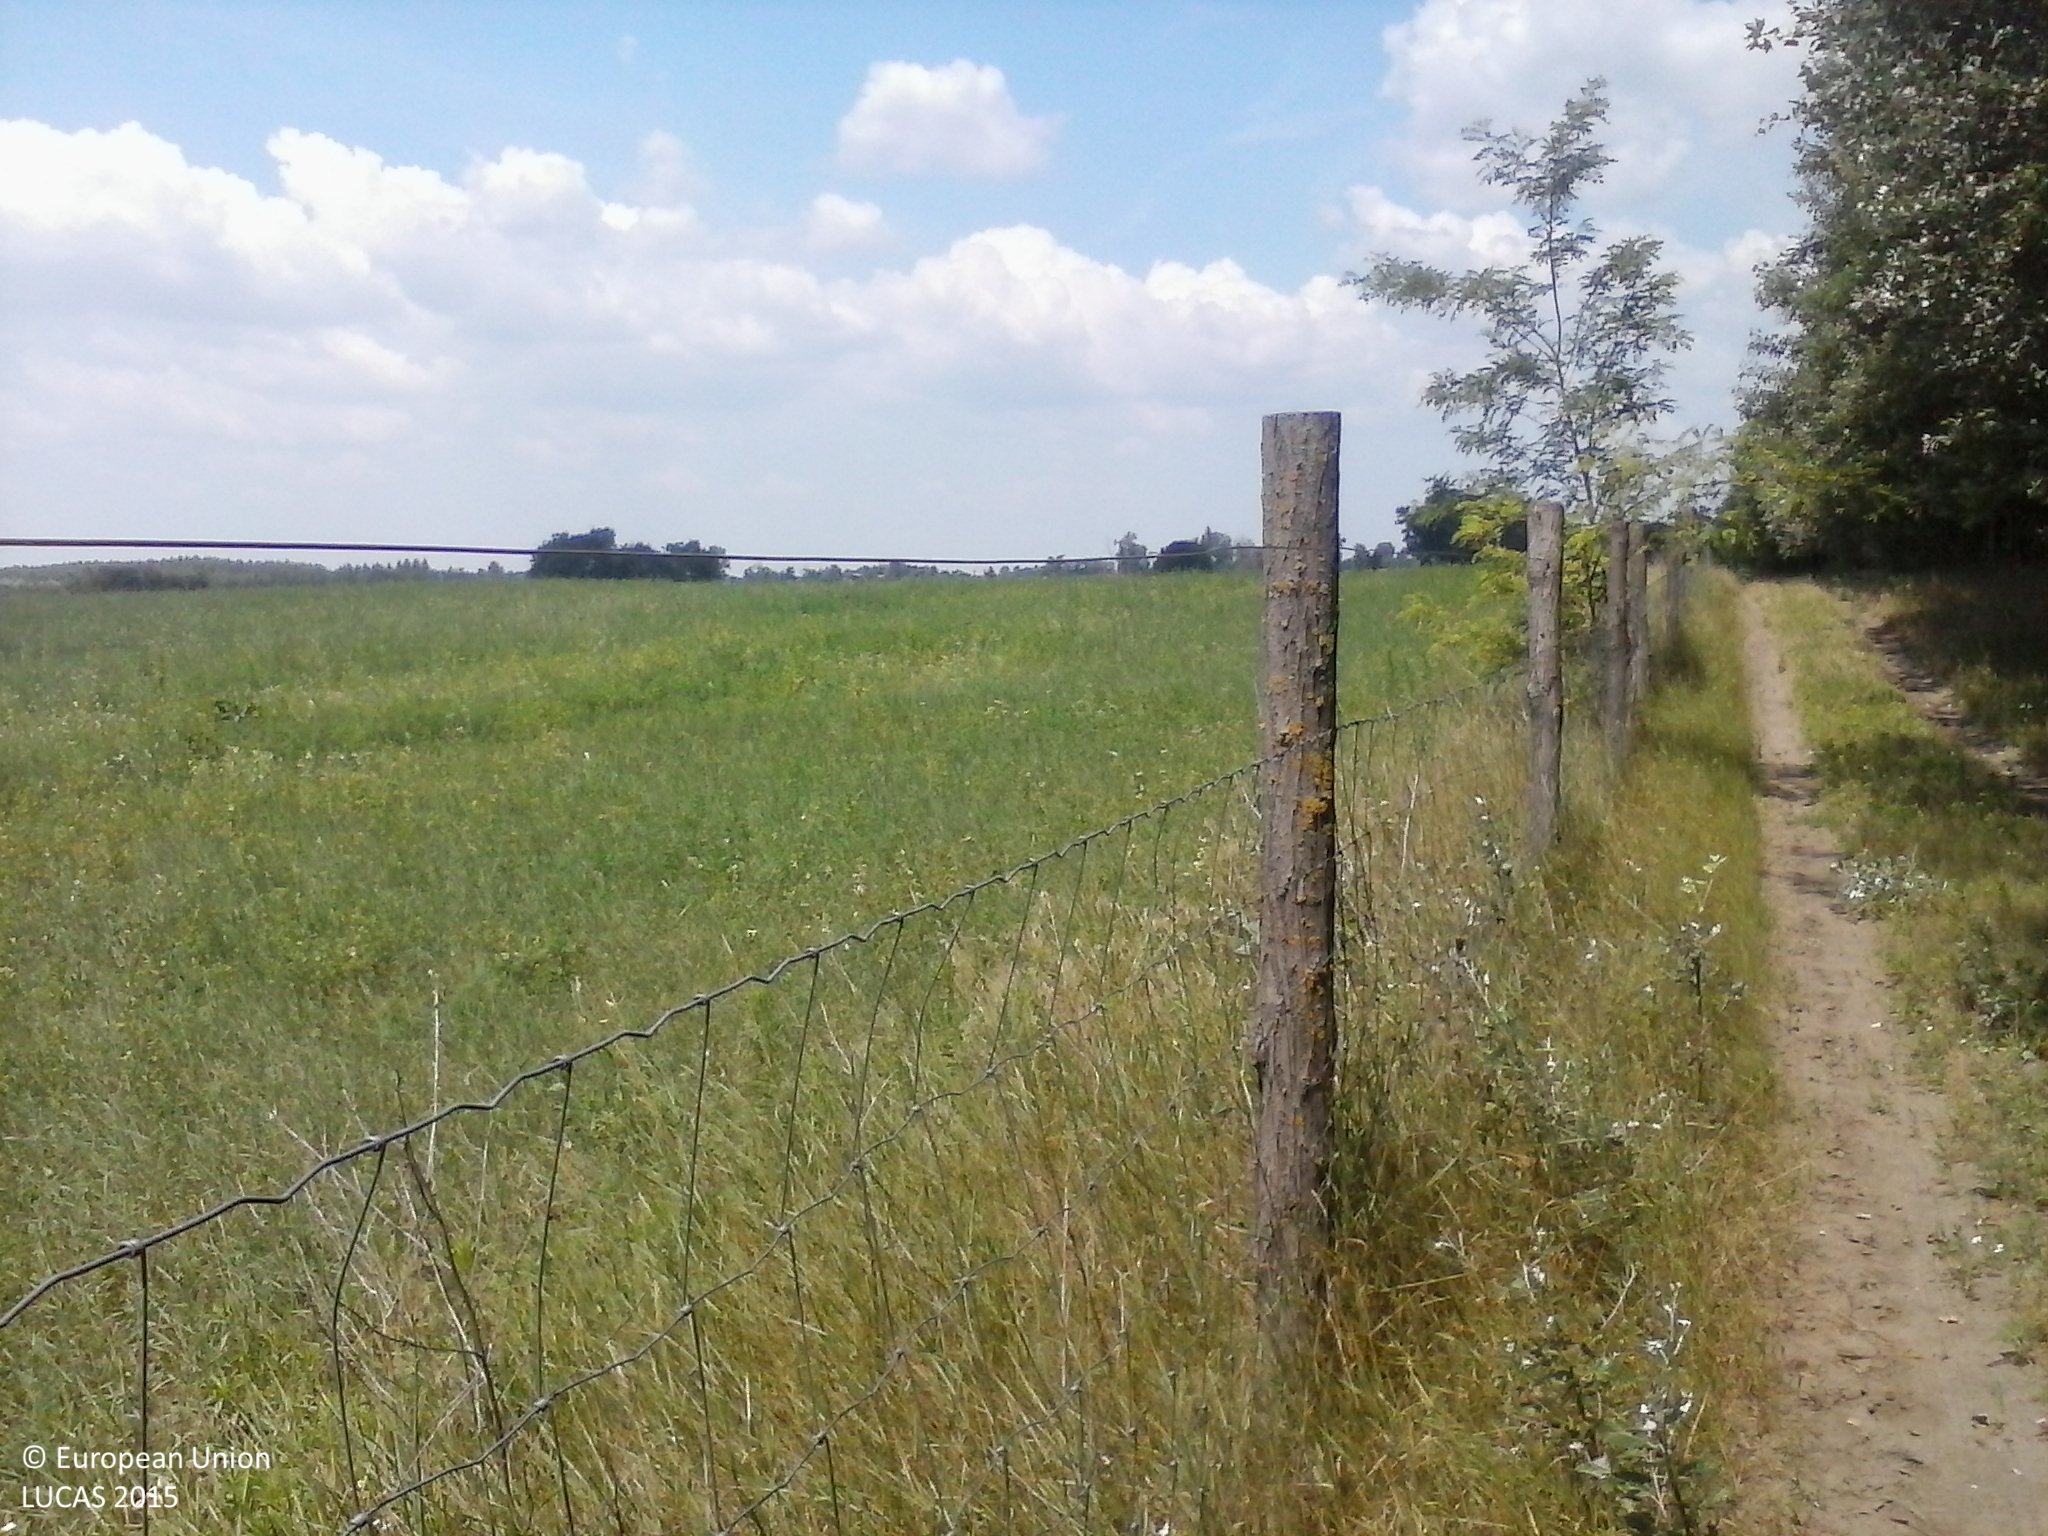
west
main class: Cropland
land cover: Lucerne
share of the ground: > 75 %
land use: Agriculture (excluding fallow land and kitchen gardens)
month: July
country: HU
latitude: 46.2850
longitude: 19.5567
